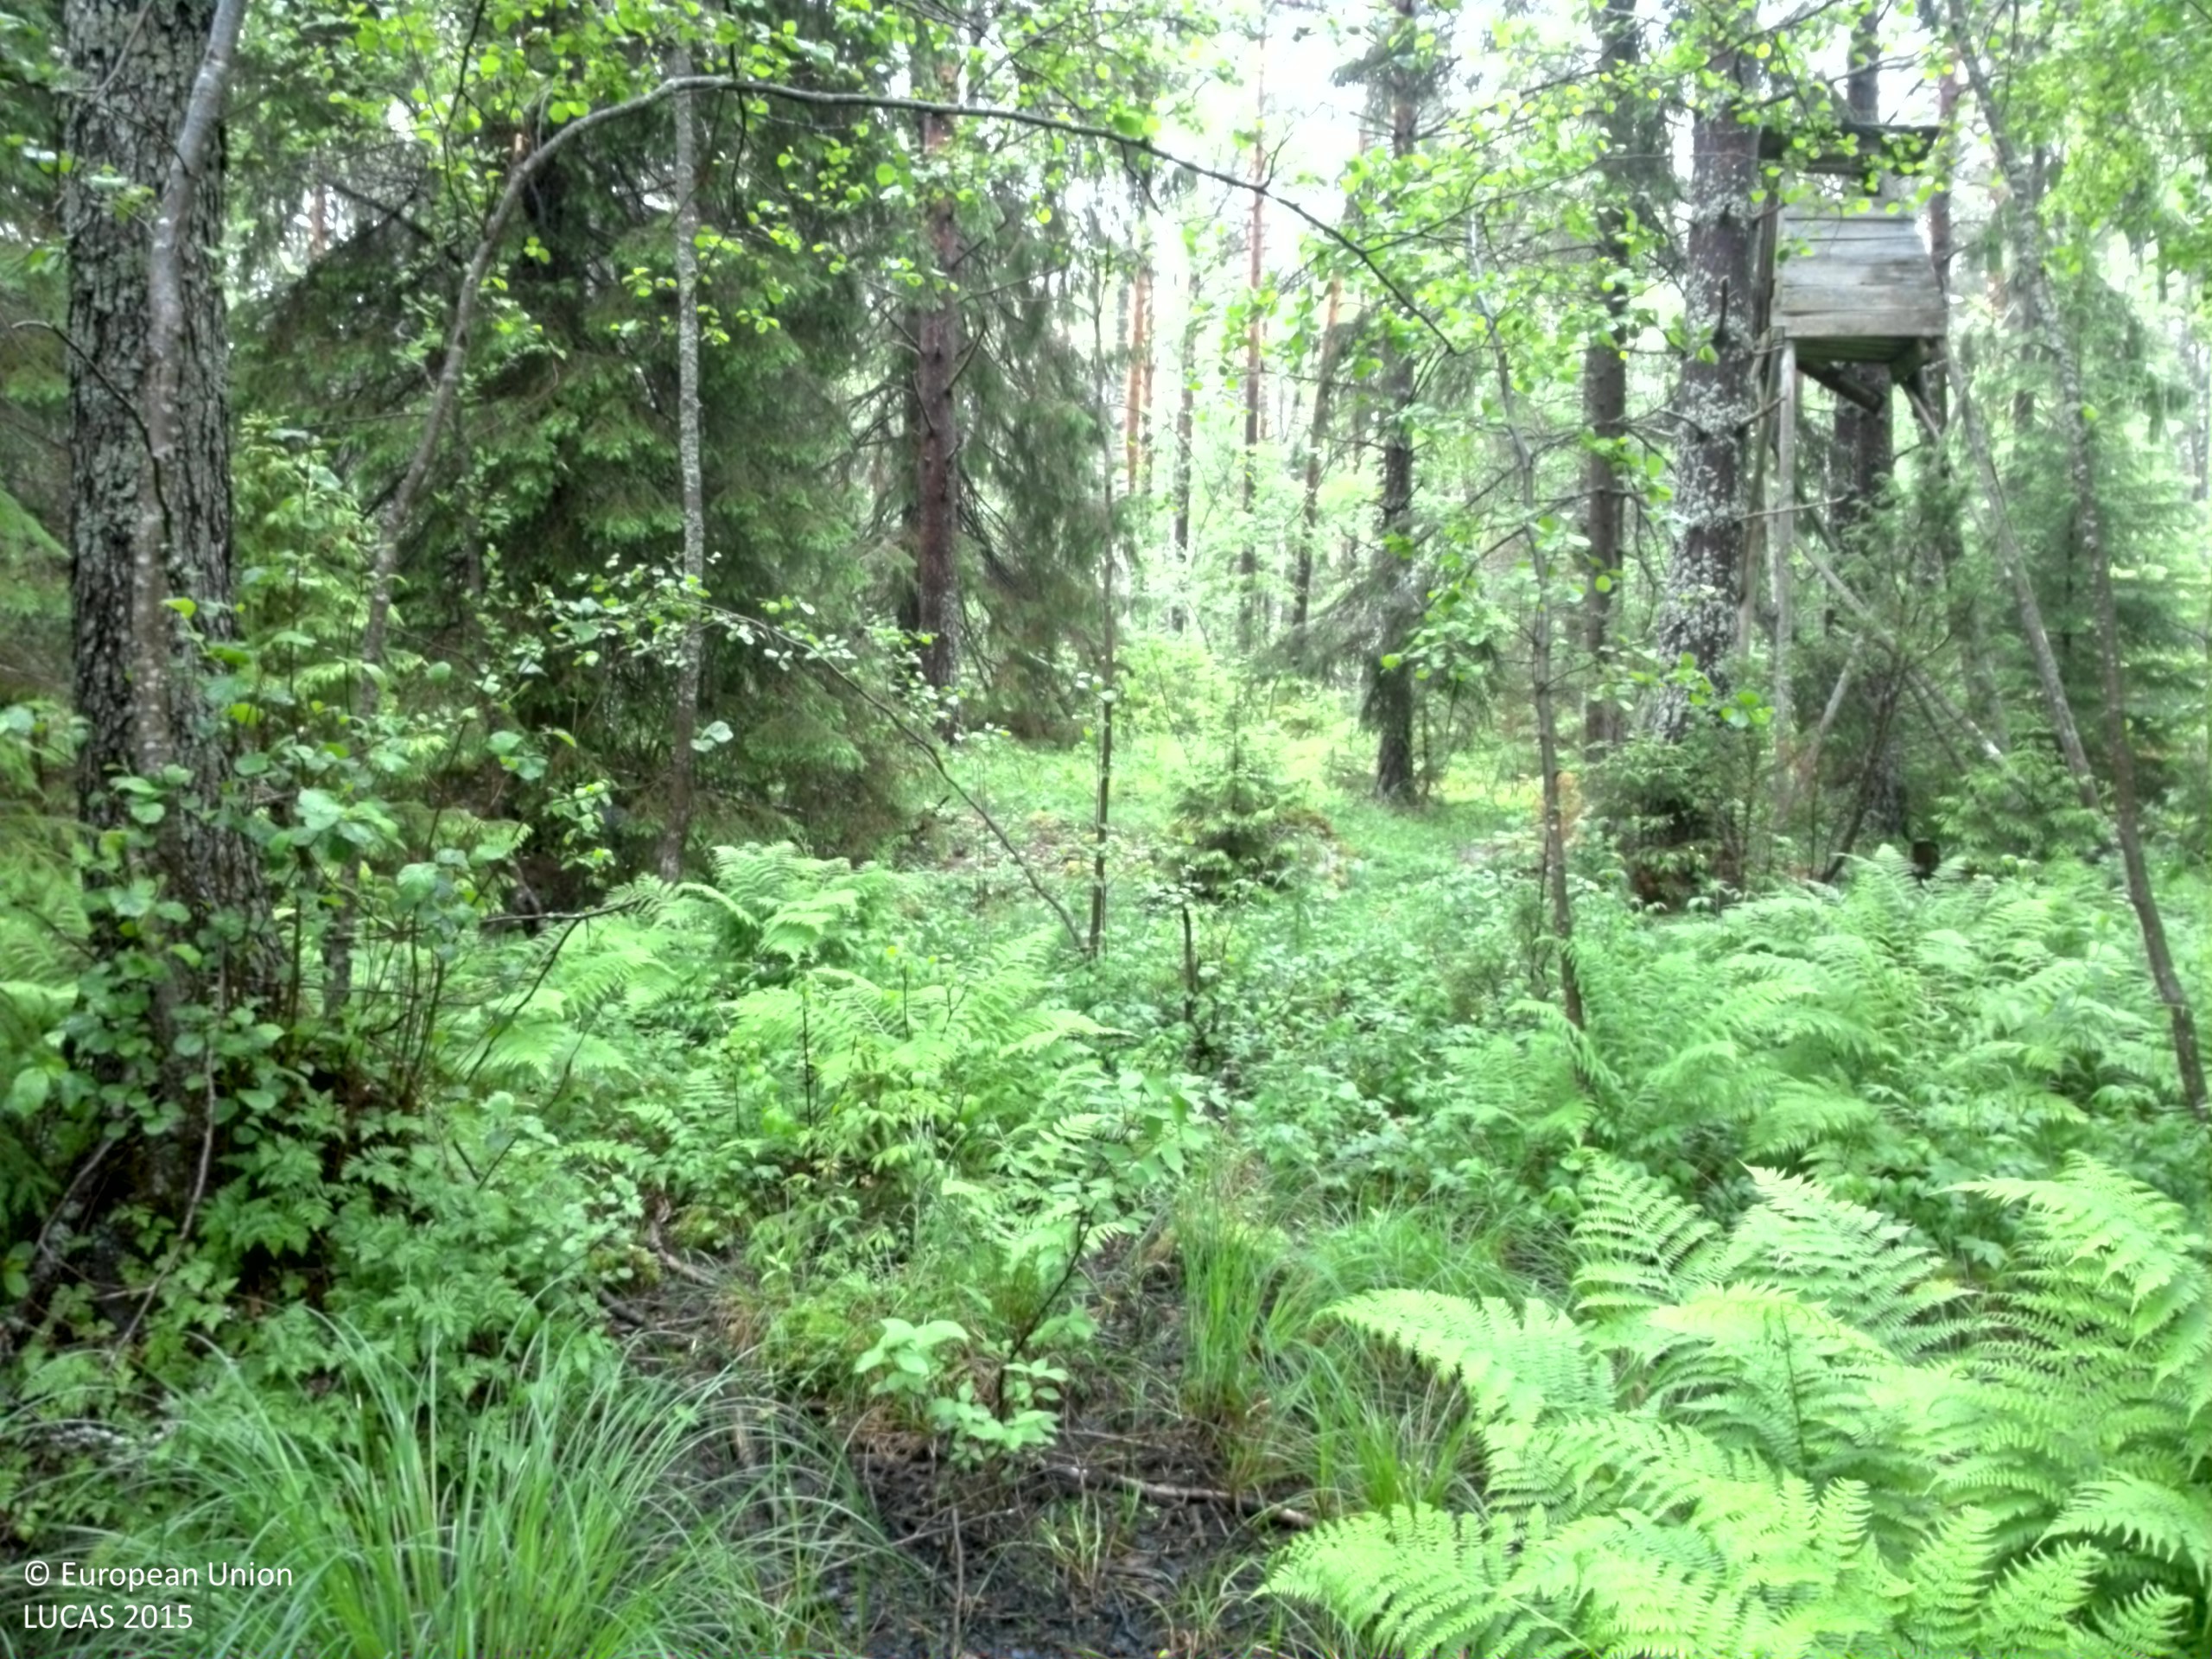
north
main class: Woodland
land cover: Broadleaved woodland
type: boreal forest
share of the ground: 50 - 75 %
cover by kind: broadleaved forest trees 50 %, herbaceous plants 25 %, coniferous forest trees 15 %, shrubs 5 %, lichens and mosses 5 %
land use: Forestry
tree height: > 5 m
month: June
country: SE
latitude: 60.4000
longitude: 18.1066
